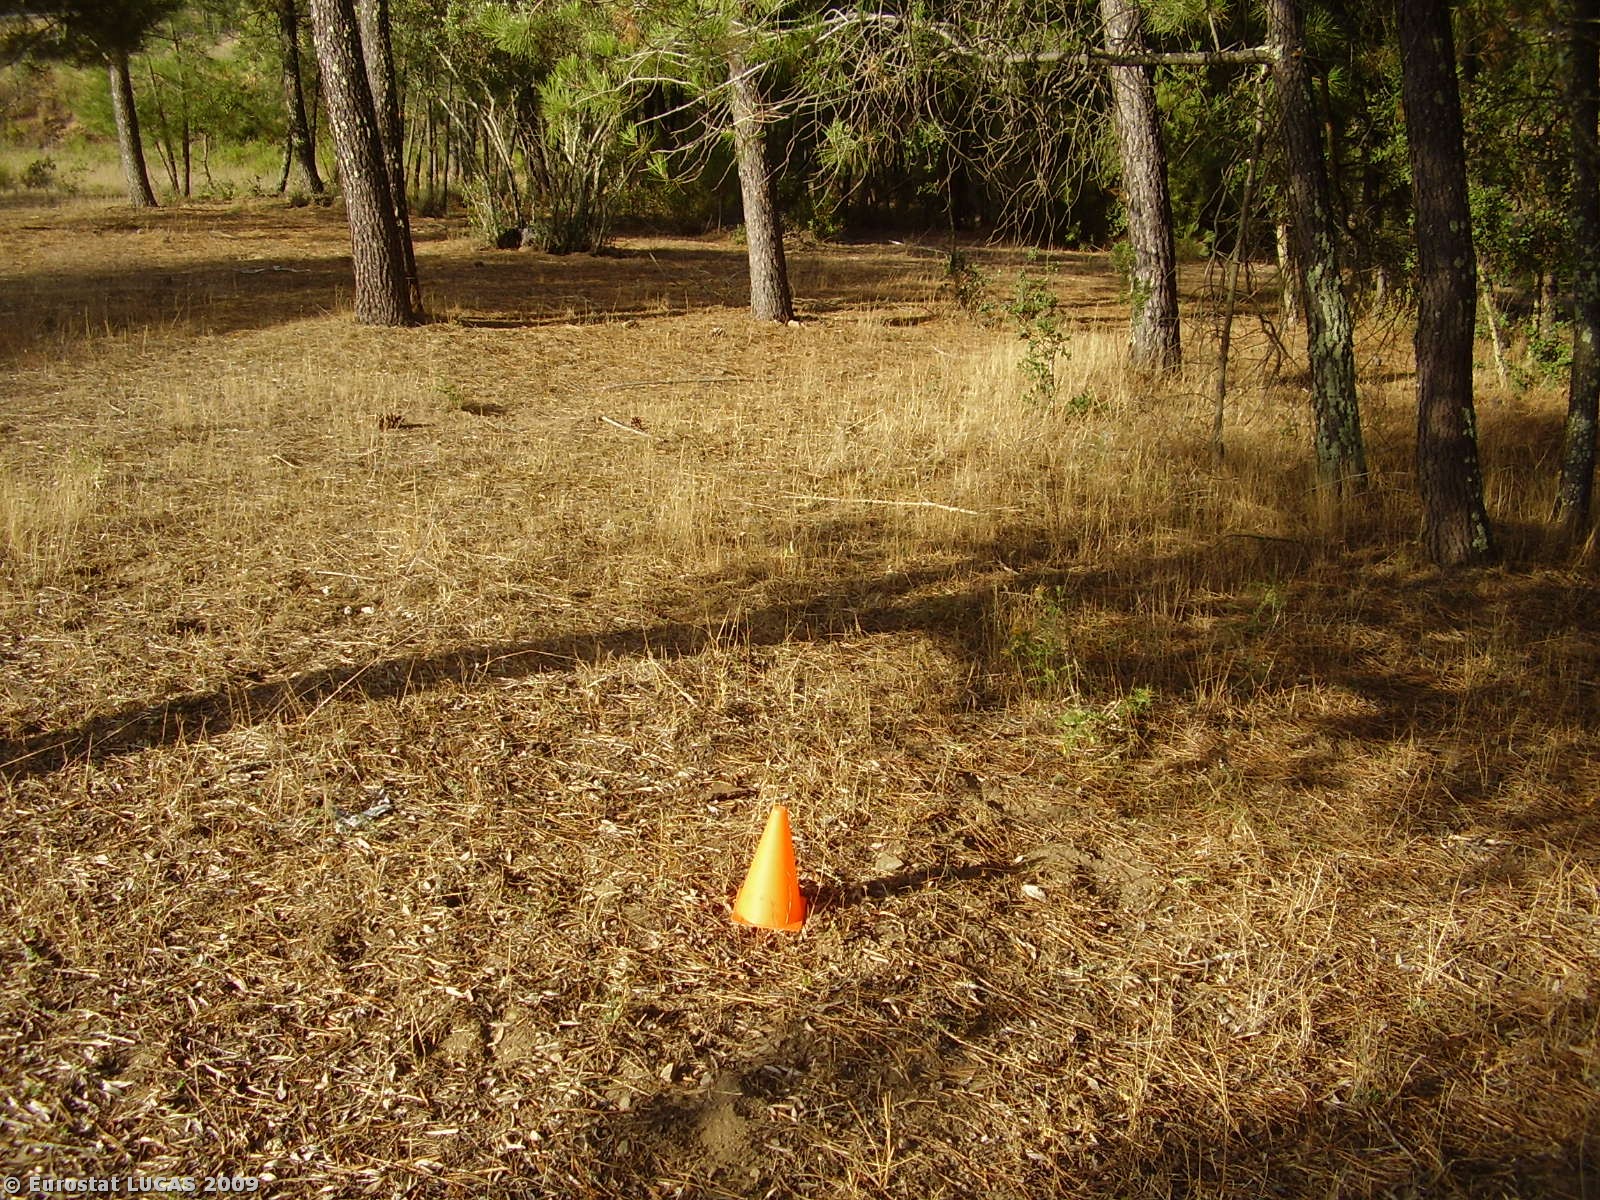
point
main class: Woodland
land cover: Coniferous woodland
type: coniferous forest of the mediterranean region
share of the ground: < 10 %
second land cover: Spontaneously vegetated surfaces
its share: > 75 %
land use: Forestry
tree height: > 5 m
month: July
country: PT
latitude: 39.4929
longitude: -8.0963
